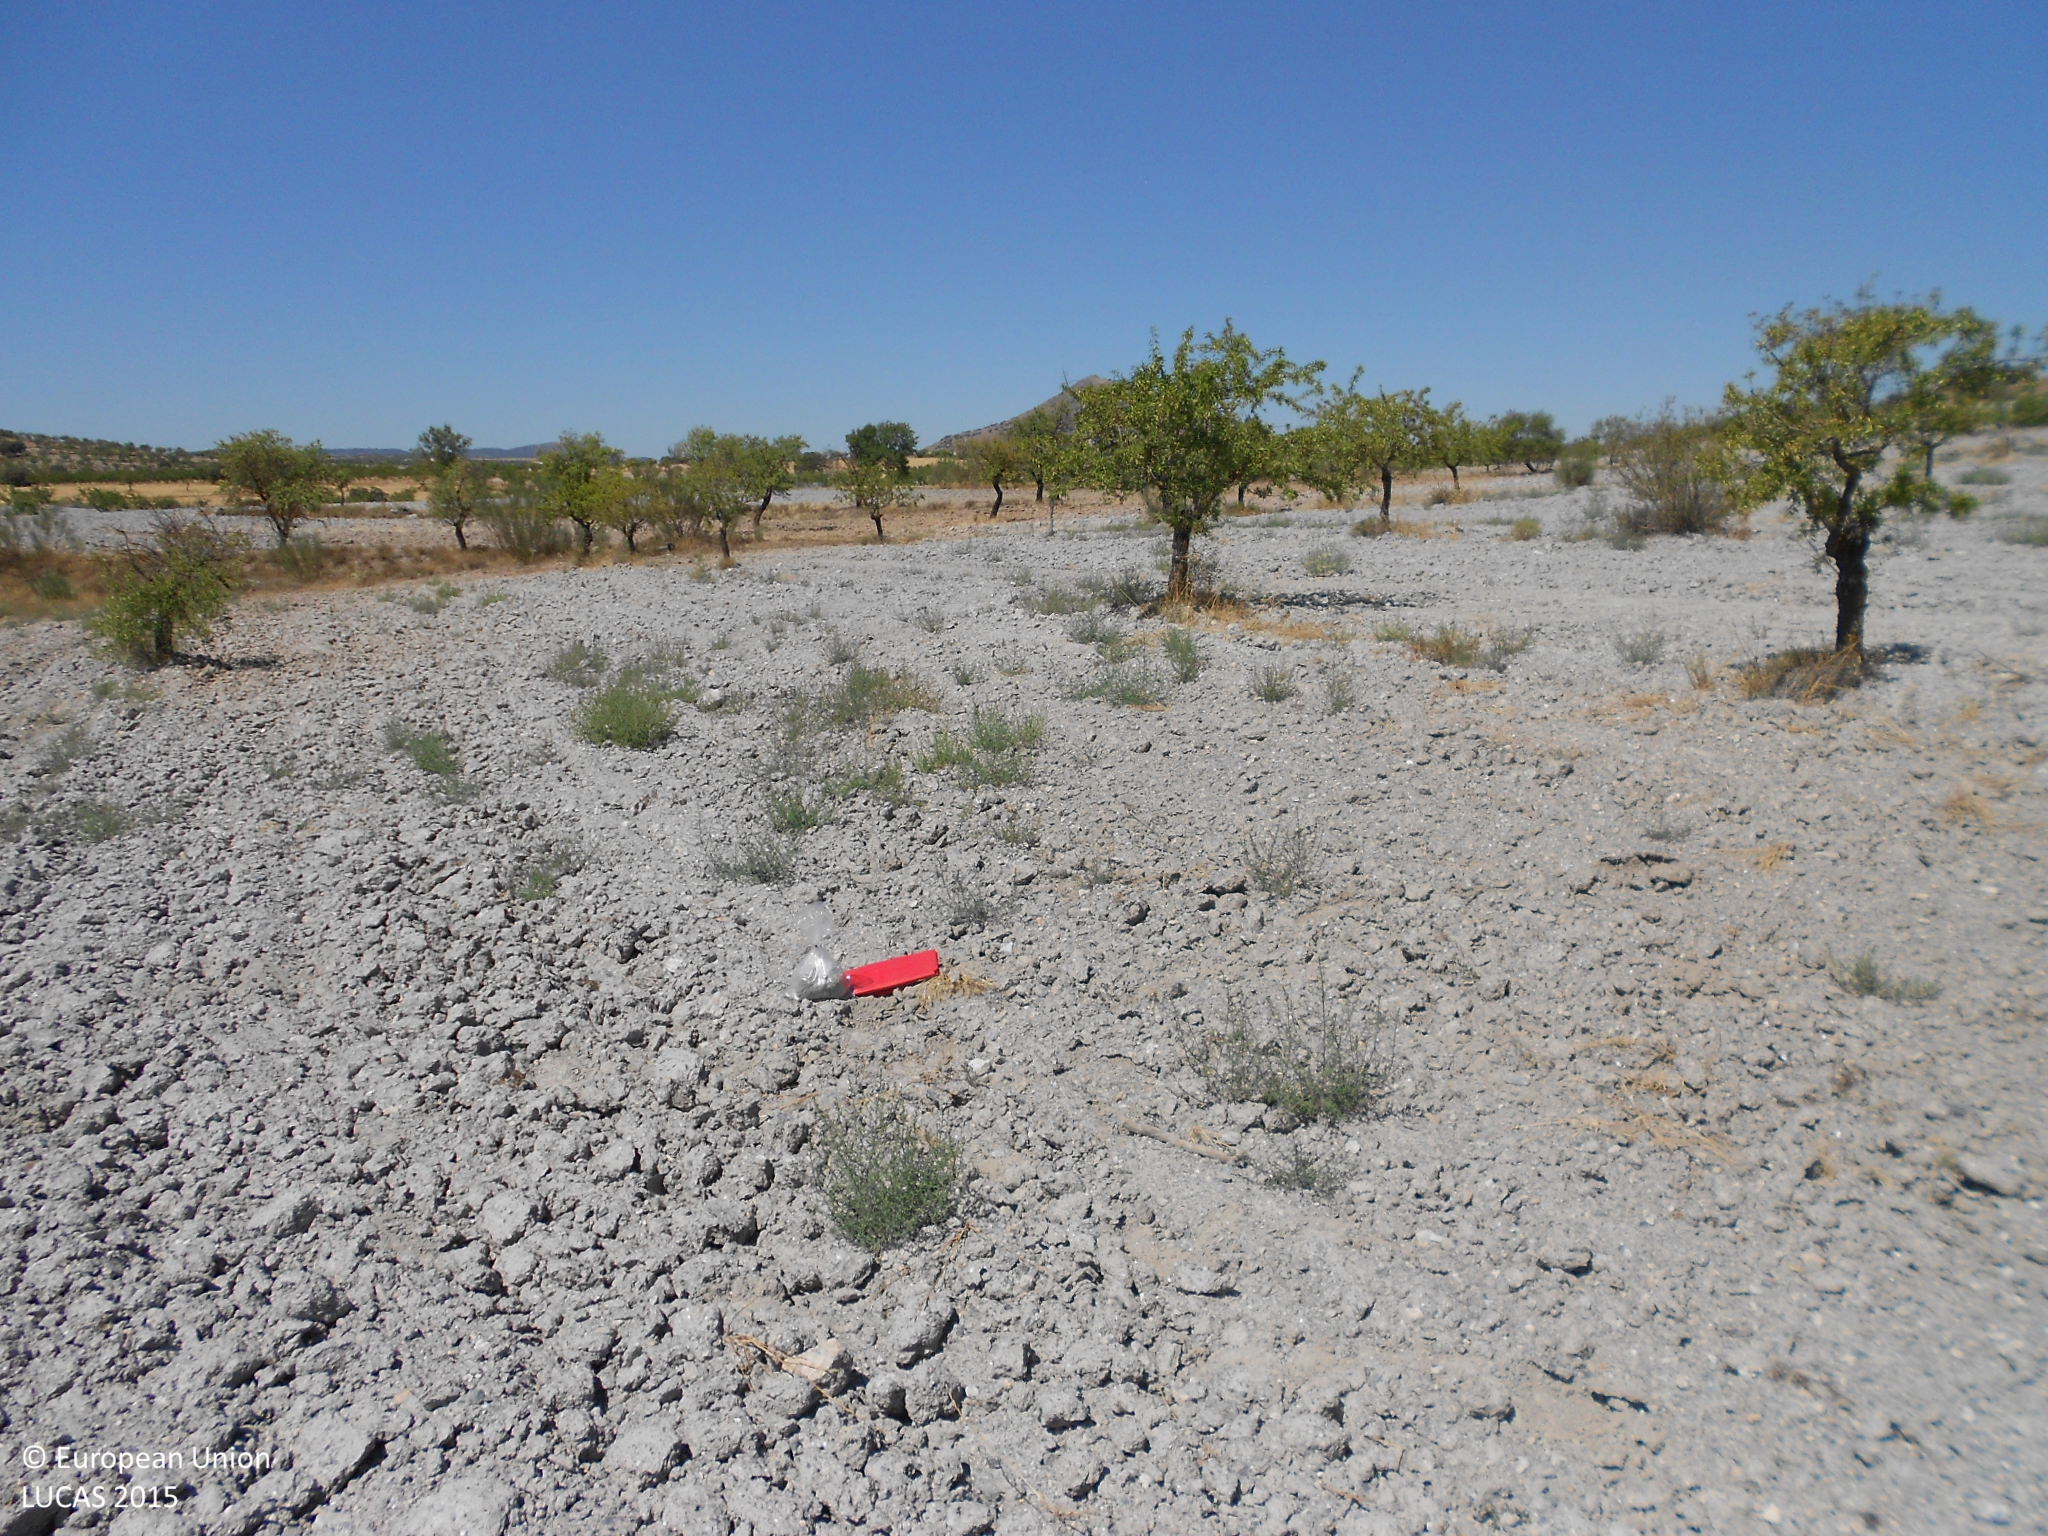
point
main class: Cropland
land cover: Nuts trees
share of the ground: < 10 %
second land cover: Other bare soil
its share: > 75 %
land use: Agriculture (excluding fallow land and kitchen gardens)
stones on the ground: > 50 %
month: July
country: ES
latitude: 37.5756
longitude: -2.2473
